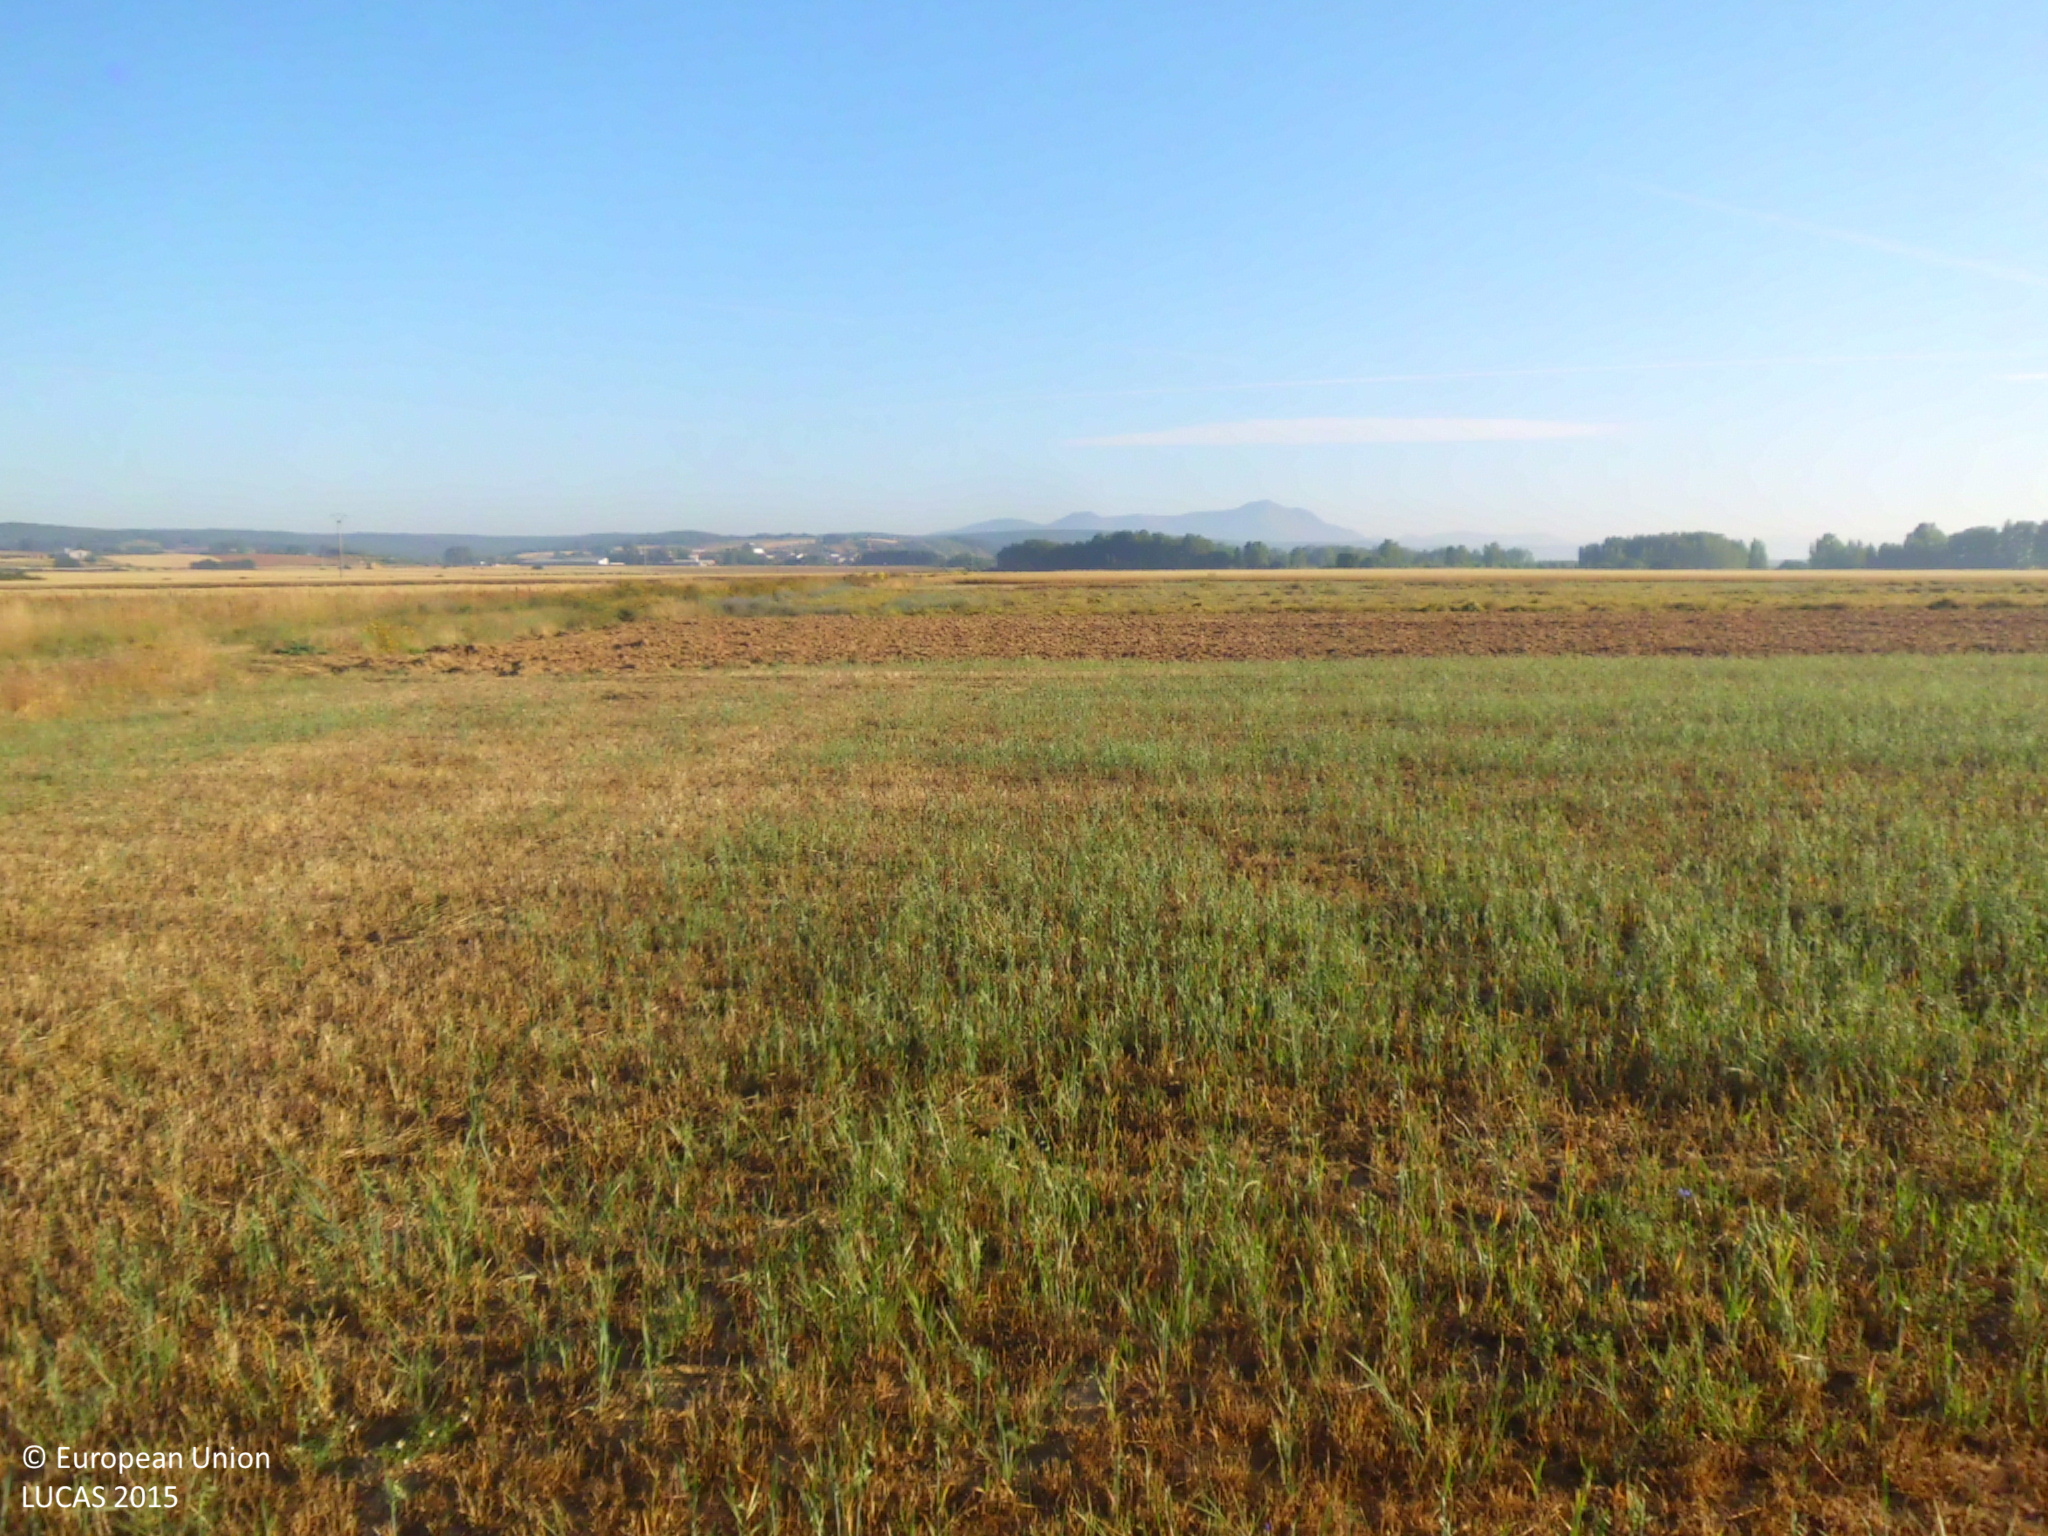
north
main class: Grassland
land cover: Spontaneously vegetated surfaces
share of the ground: 50 - 75 %
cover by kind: herbaceous plants 60 %, unconsolidated bare surface 40 %
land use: Fallow land
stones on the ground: < 10 %
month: June
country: ES
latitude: 42.6440
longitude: -5.0276
